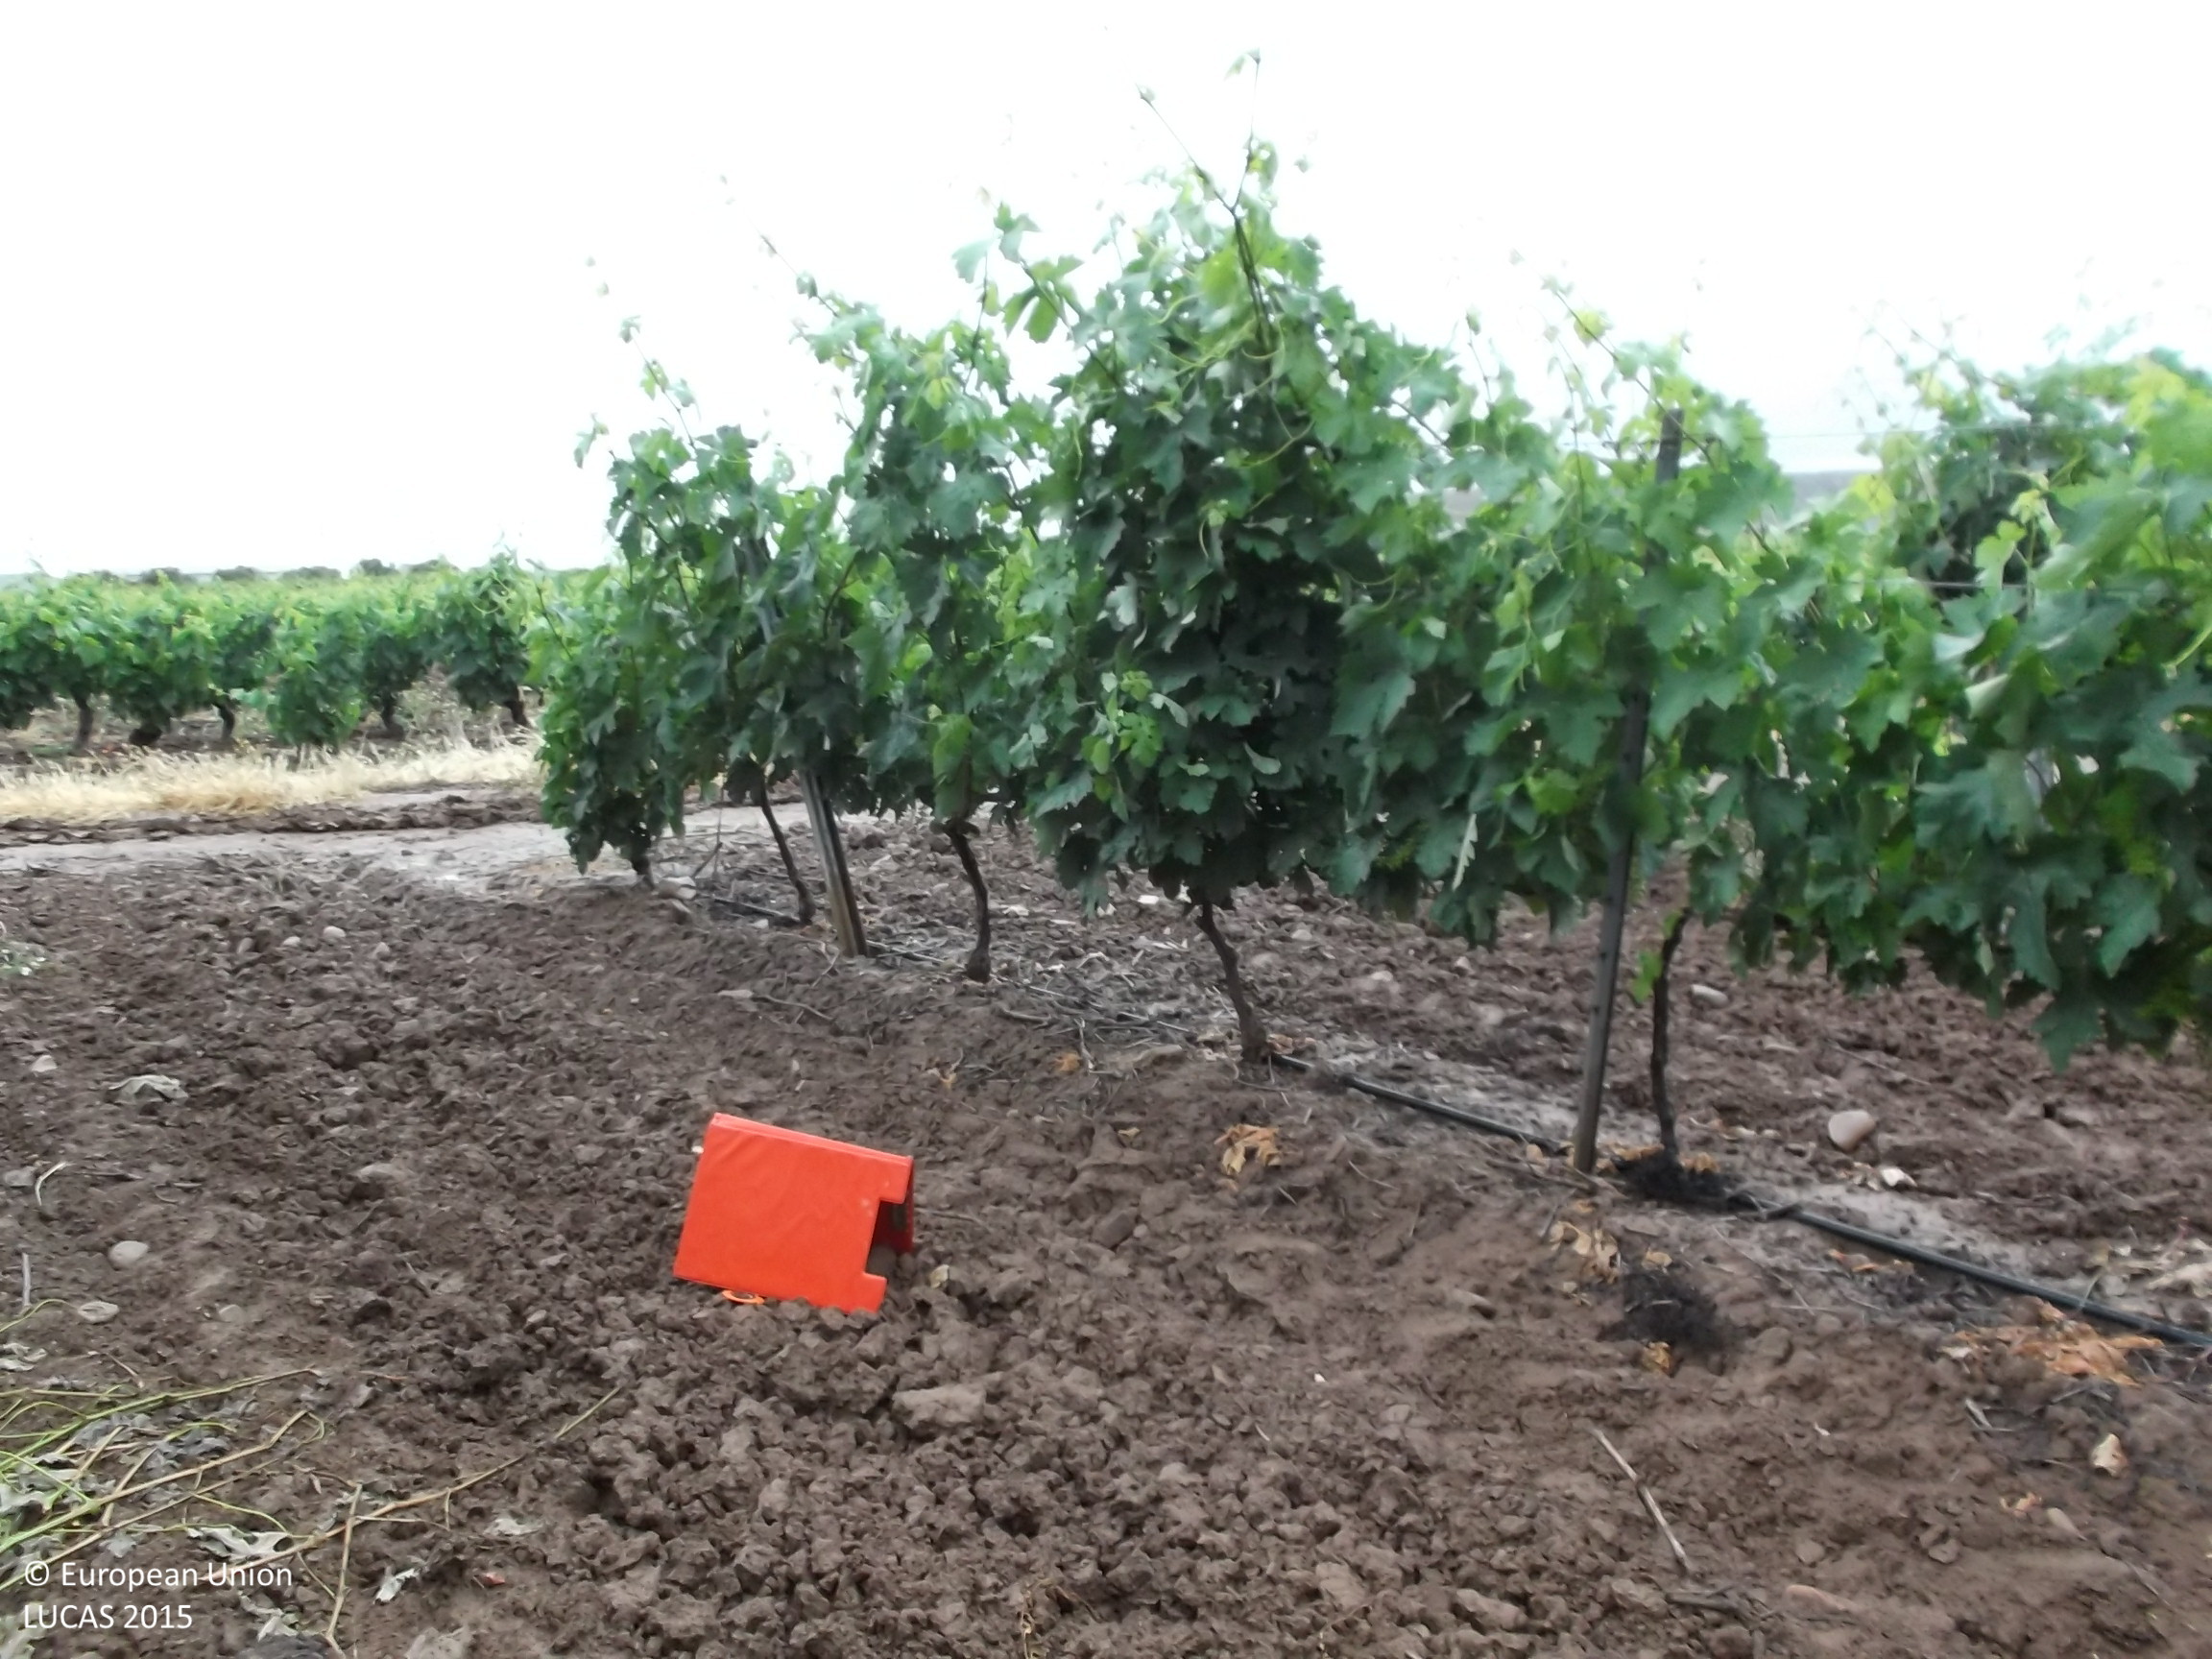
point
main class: Cropland
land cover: Vineyards
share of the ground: 10 - 25 %
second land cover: Other bare soil
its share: > 75 %
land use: Agriculture (excluding fallow land and kitchen gardens)
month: June
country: ES
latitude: 42.3966
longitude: -2.1282
